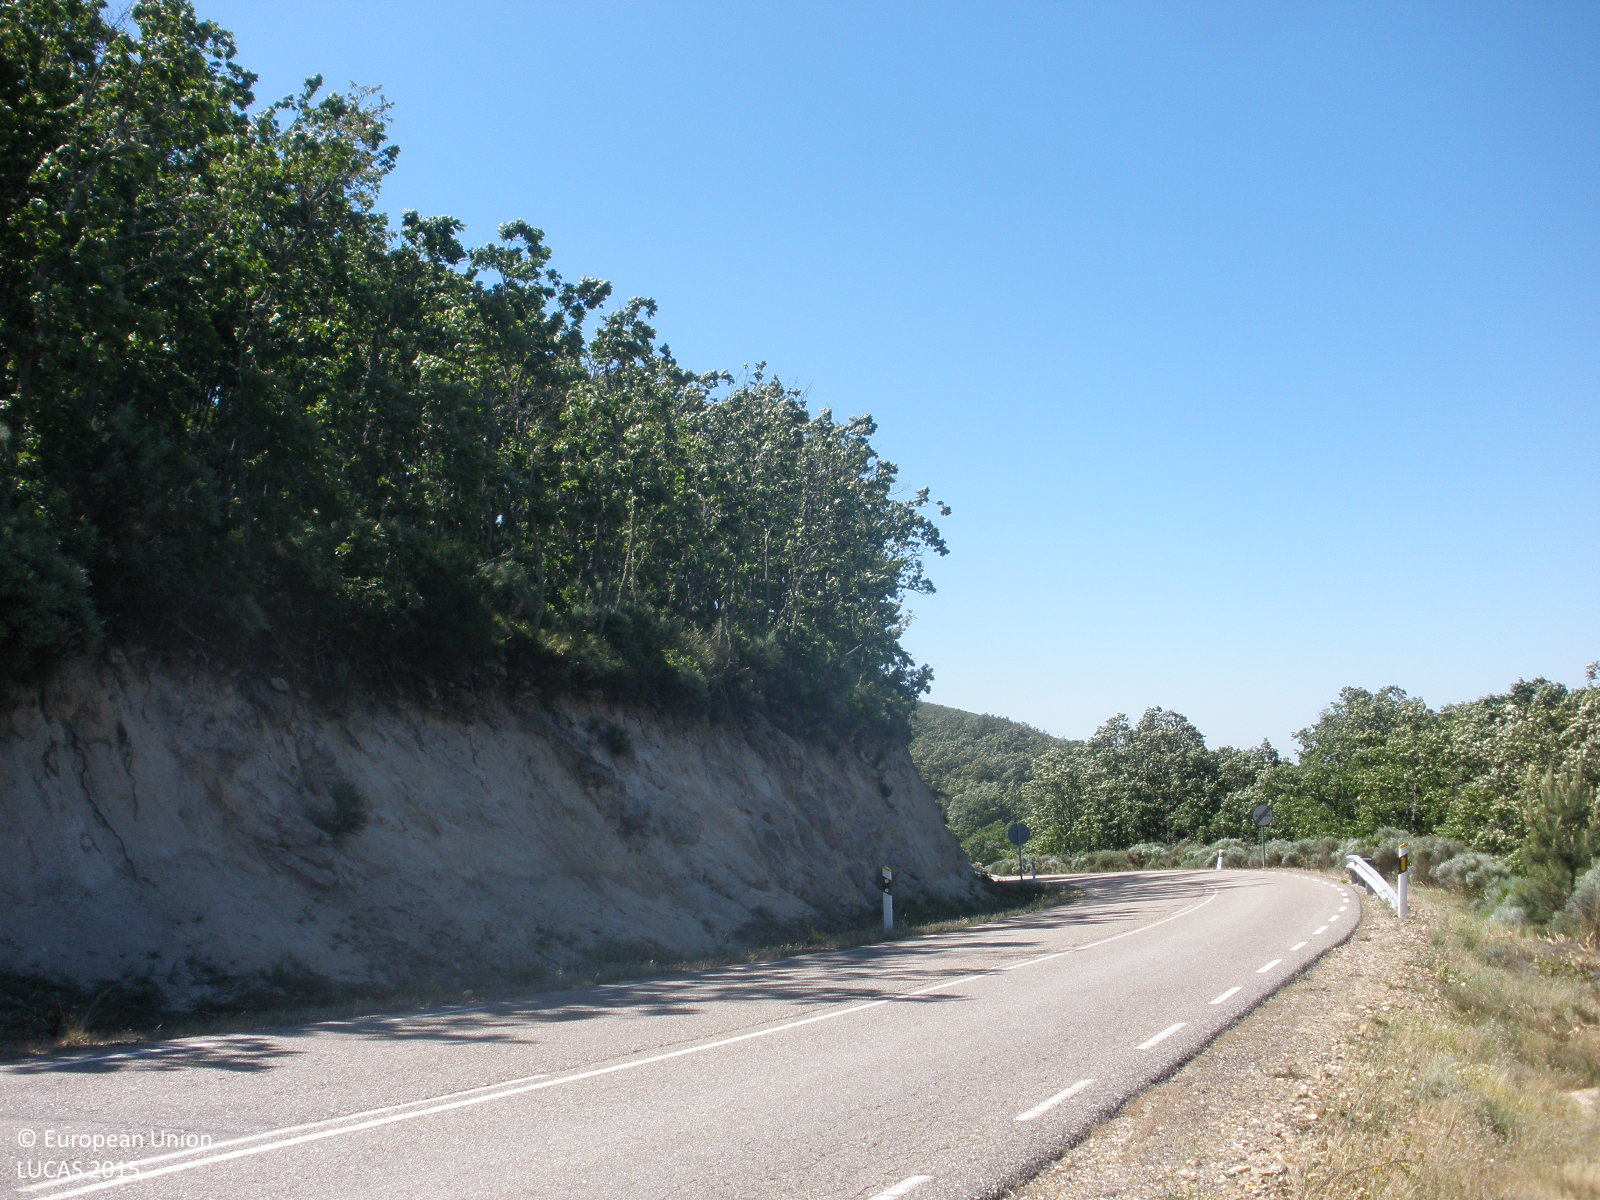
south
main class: Woodland
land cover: Broadleaved woodland
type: broadleaved evergreen forest
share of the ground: > 75 %
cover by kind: broadleaved forest trees 90 %, shrubs 10 %
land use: Forestry
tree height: < 5 m
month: May
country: ES
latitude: 40.2278
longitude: -6.7897
